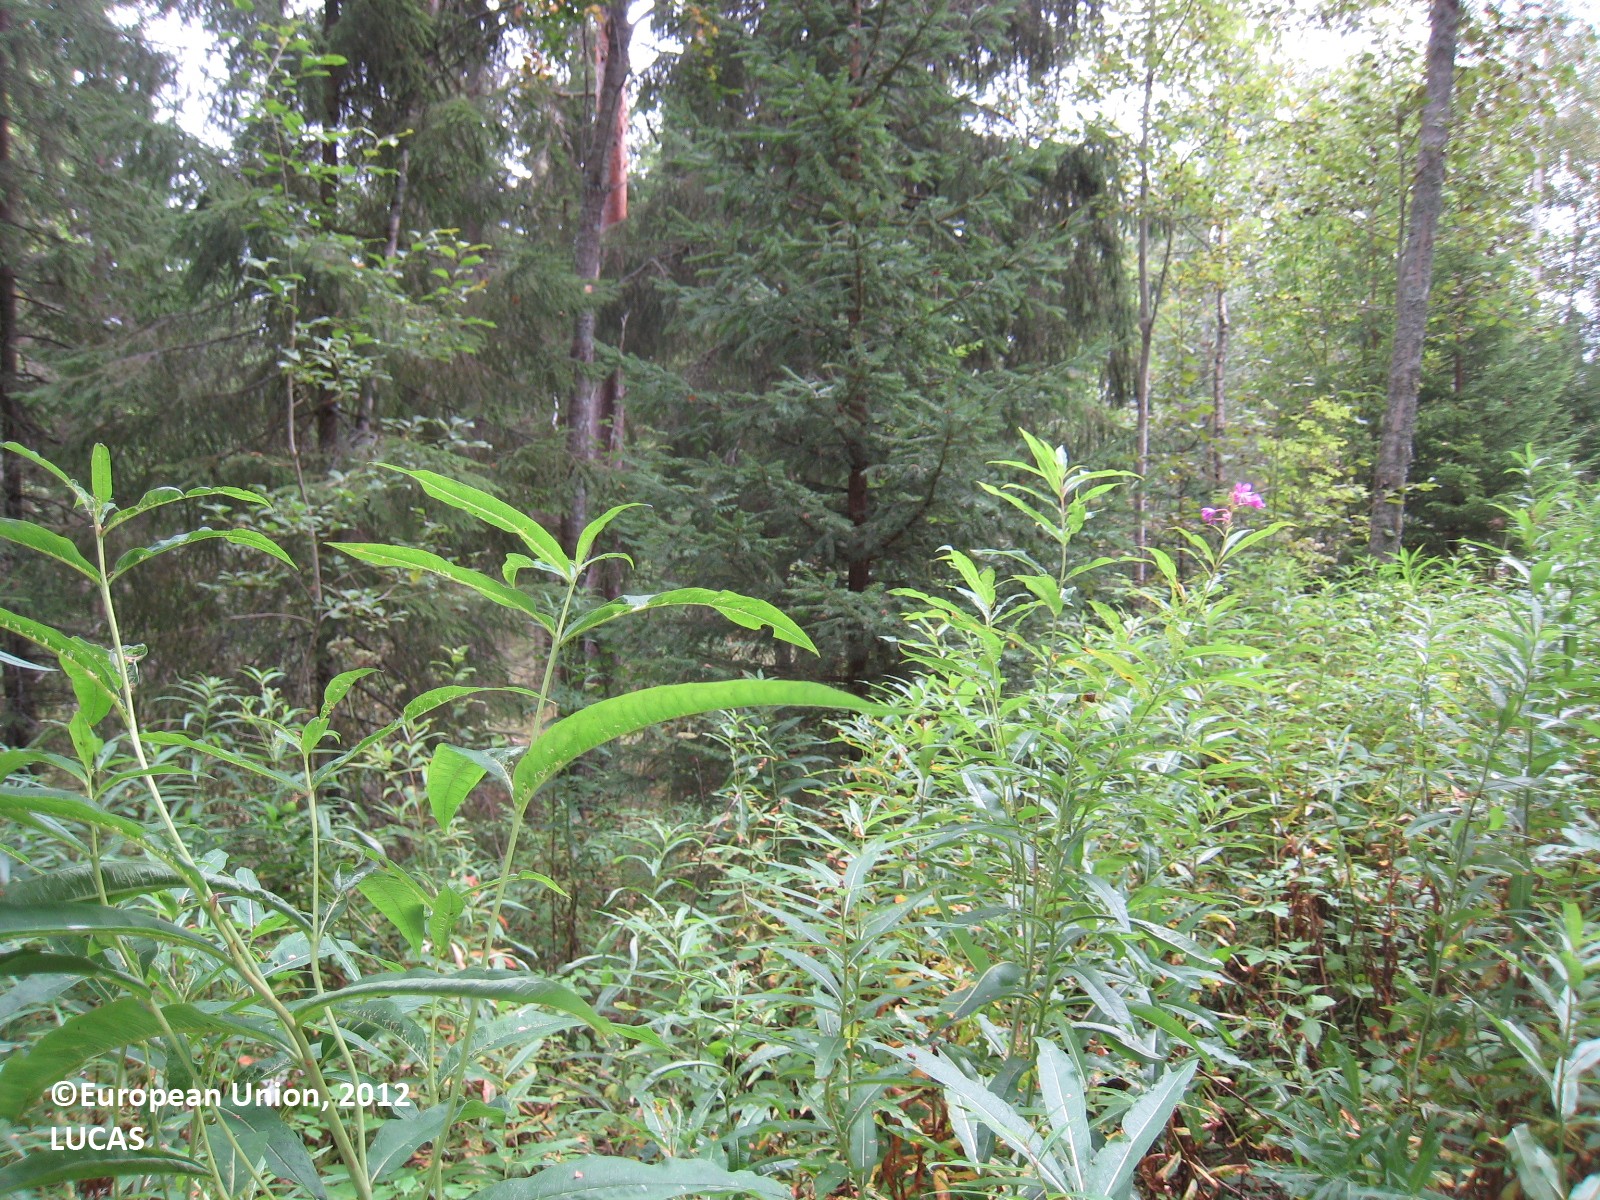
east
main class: Woodland
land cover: Spruce dominated mixed woodland
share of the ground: 50 - 75 %
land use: Forestry
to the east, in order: Spruce dominated mixed woodland; Spruce dominated coniferous woodland; Ditches and canals; Shruby margins; Tracks; Shruby margins; Ditches and canals; Broadleaved woodland; Ditches and canals; Grassland without tree/shrub cover; Broadleaved woodland; Grassland without tree/shrub cover; Ditches and canals; Other mixed woodland; Ditches and canals; Pine dominated mixed woodland; Other coniferous woodland
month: August
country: FI
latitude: 62.3675
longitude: 27.3853
